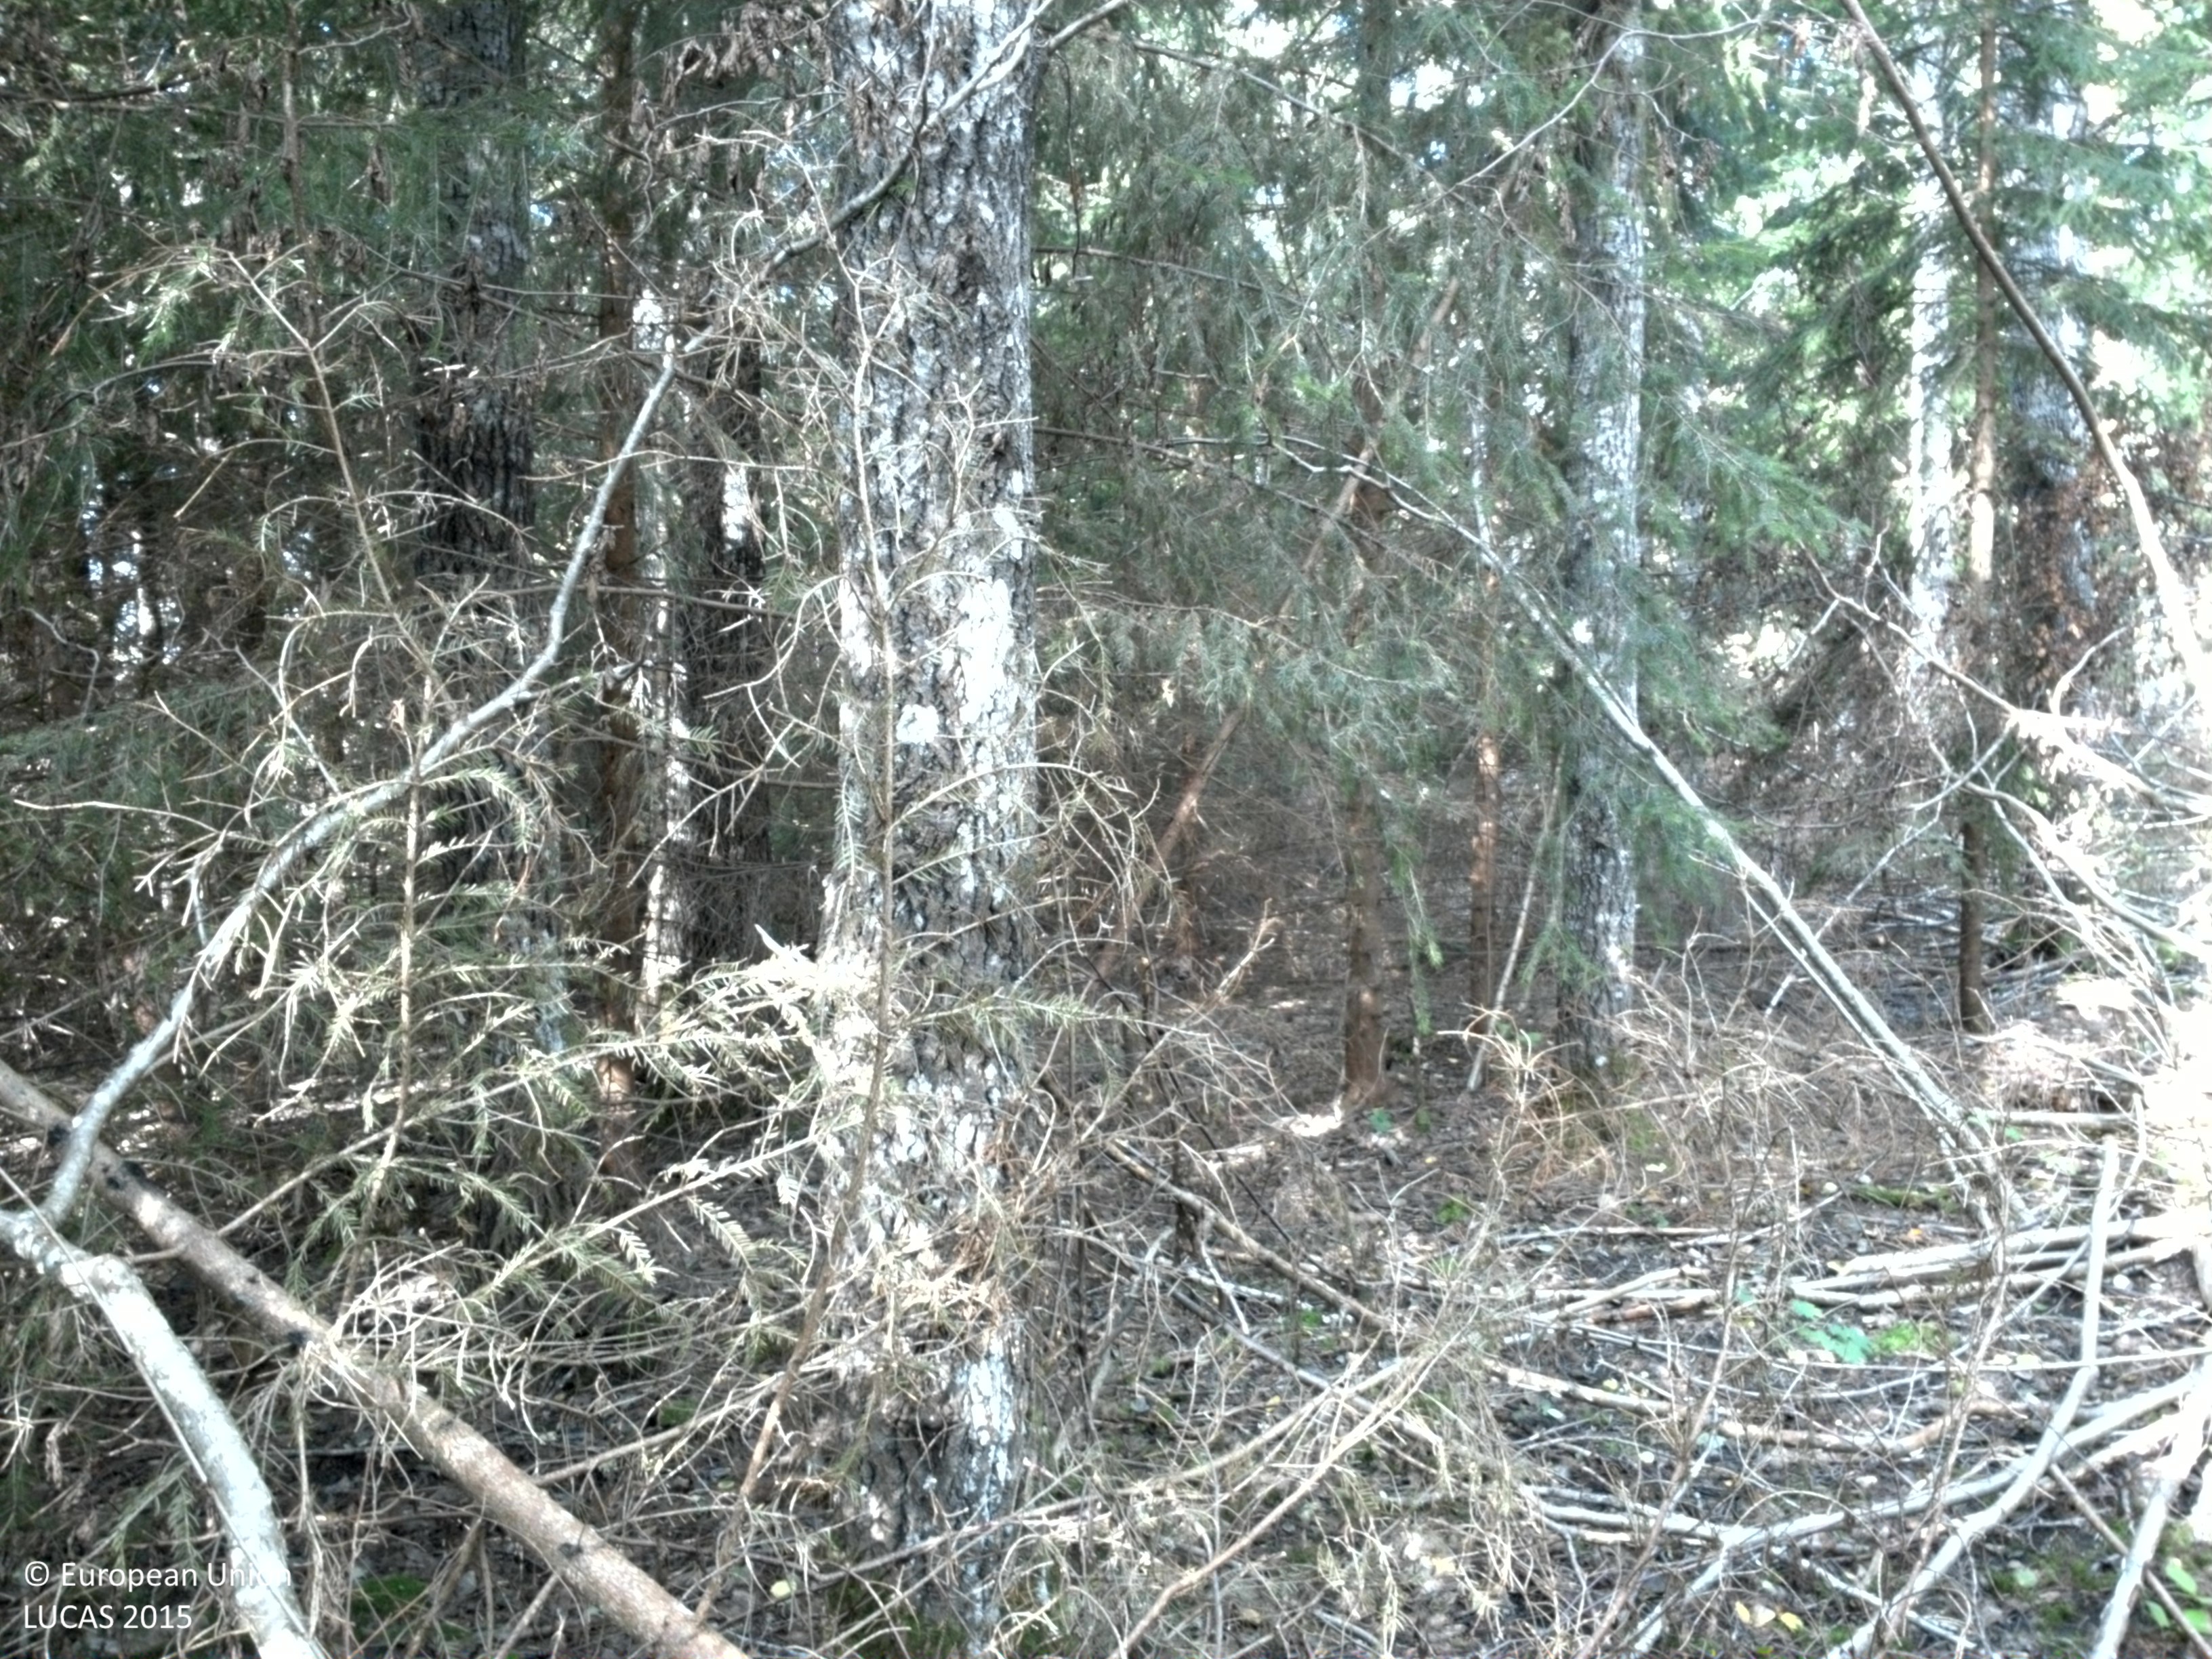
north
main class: Woodland
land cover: Broadleaved woodland
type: hemiboreal forest and nemoral coniferous forest and mixed broadleaved-coniferous forest
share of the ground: > 75 %
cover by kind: broadleaved forest trees 70 %, coniferous forest trees 10 %, lichens and mosses 10 %, unconsolidated bare surface 10 %
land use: Forestry
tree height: > 5 m
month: September
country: SE
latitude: 59.8844
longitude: 18.8448
